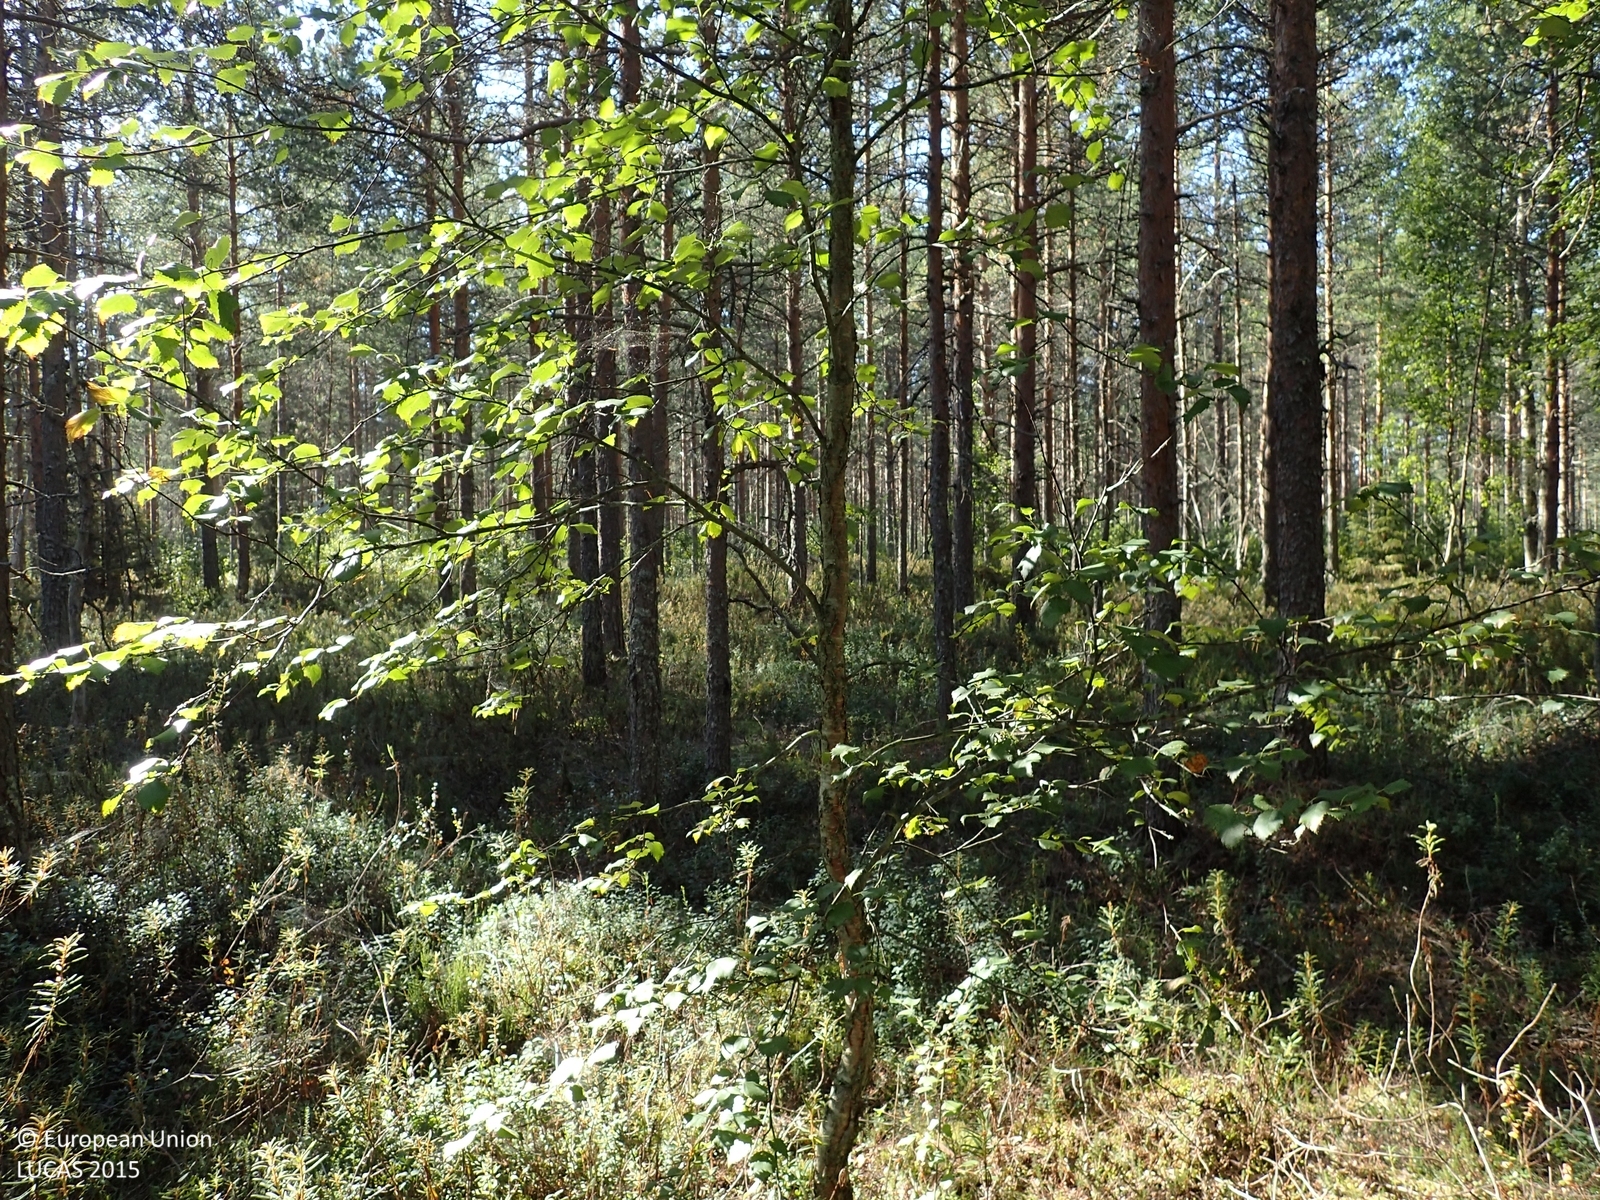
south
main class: Woodland
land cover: Pine dominated coniferous woodland
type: boreal forest
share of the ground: 50 - 75 %
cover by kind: coniferous forest trees 60 %, shrubs 30 %, broadleaved forest trees 5 %, lichens and mosses 5 %
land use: Forestry
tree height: > 5 m
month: August
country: FI
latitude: 62.4263
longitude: 21.9586
